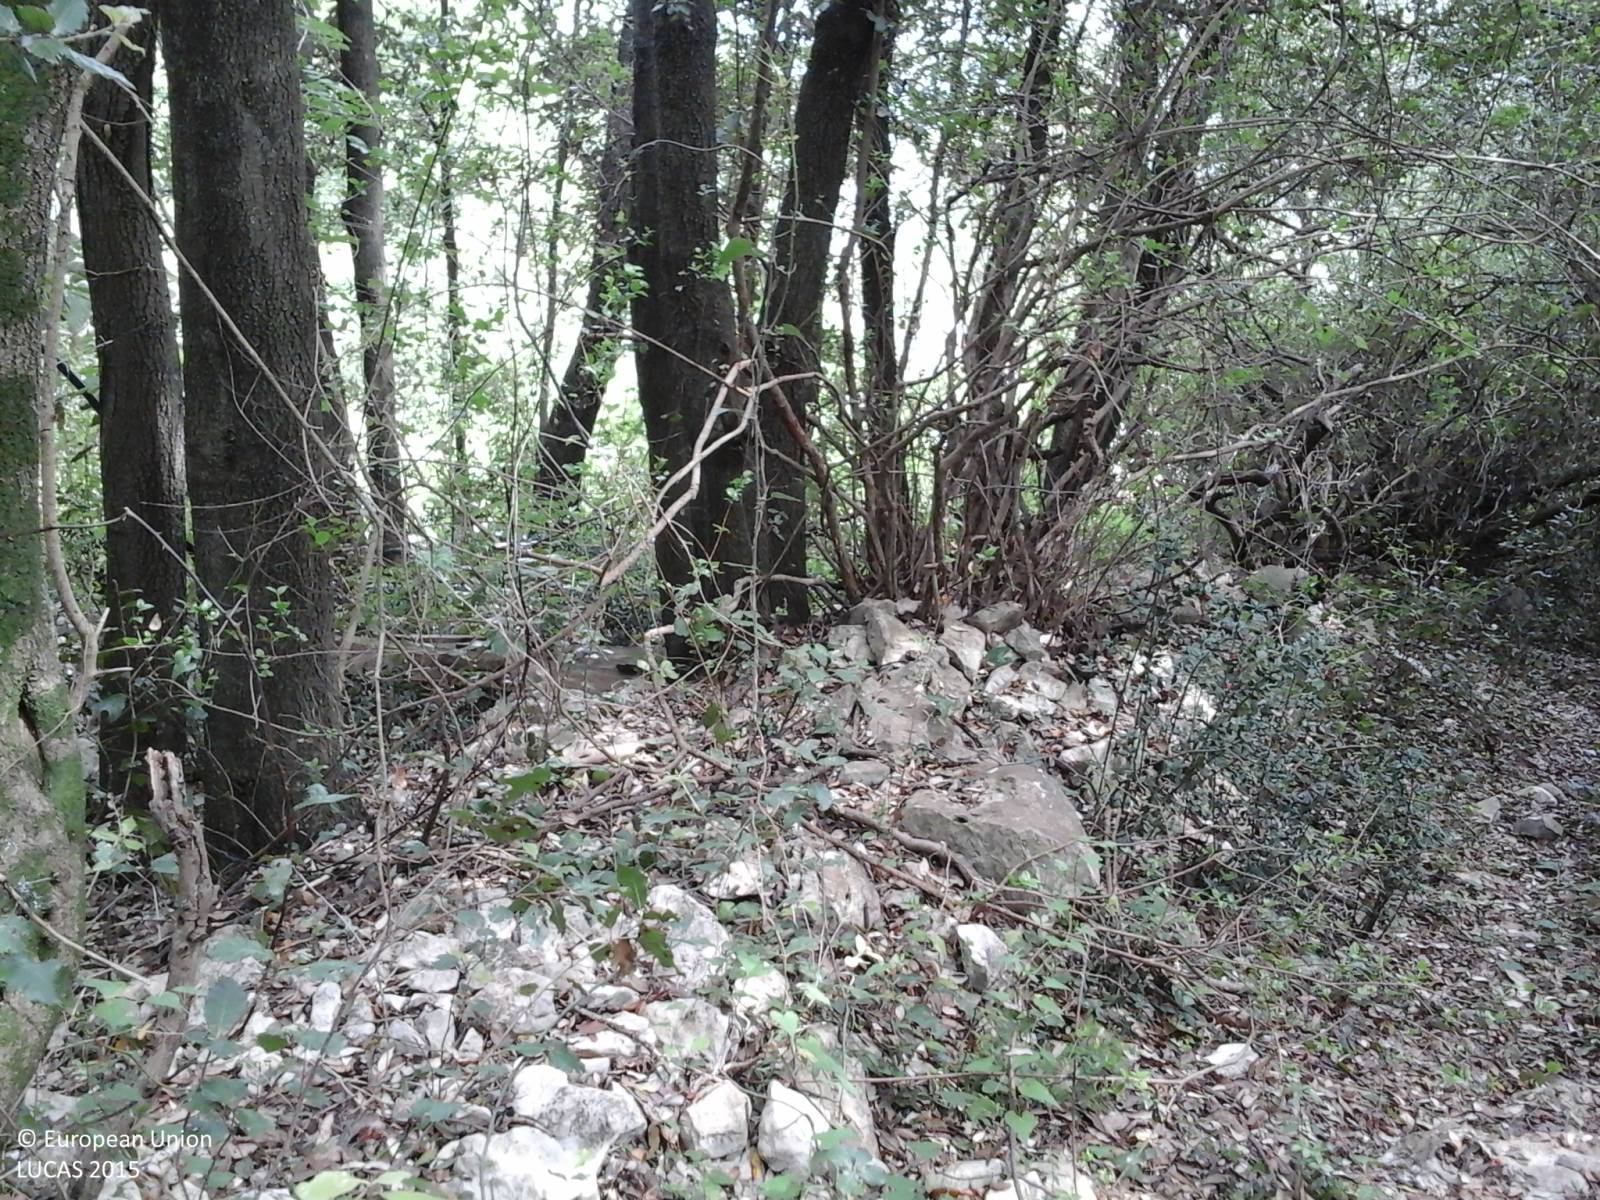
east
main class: Woodland
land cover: Broadleaved woodland
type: thermophilous deciduous forest
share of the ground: > 75 %
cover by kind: broadleaved forest trees 100 %
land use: Forestry
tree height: > 5 m
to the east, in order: Broadleaved woodland; Fences; Broadleaved woodland; Dry stone walls; Tracks; Spontaneously vegetated surfaces; Broadleaved woodland; Electric lines; Paved roads, cycling and walking lanes; Artificial constructions; Olive groves; Broadleaved woodland
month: May
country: IT
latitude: 41.2221
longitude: 14.3372
